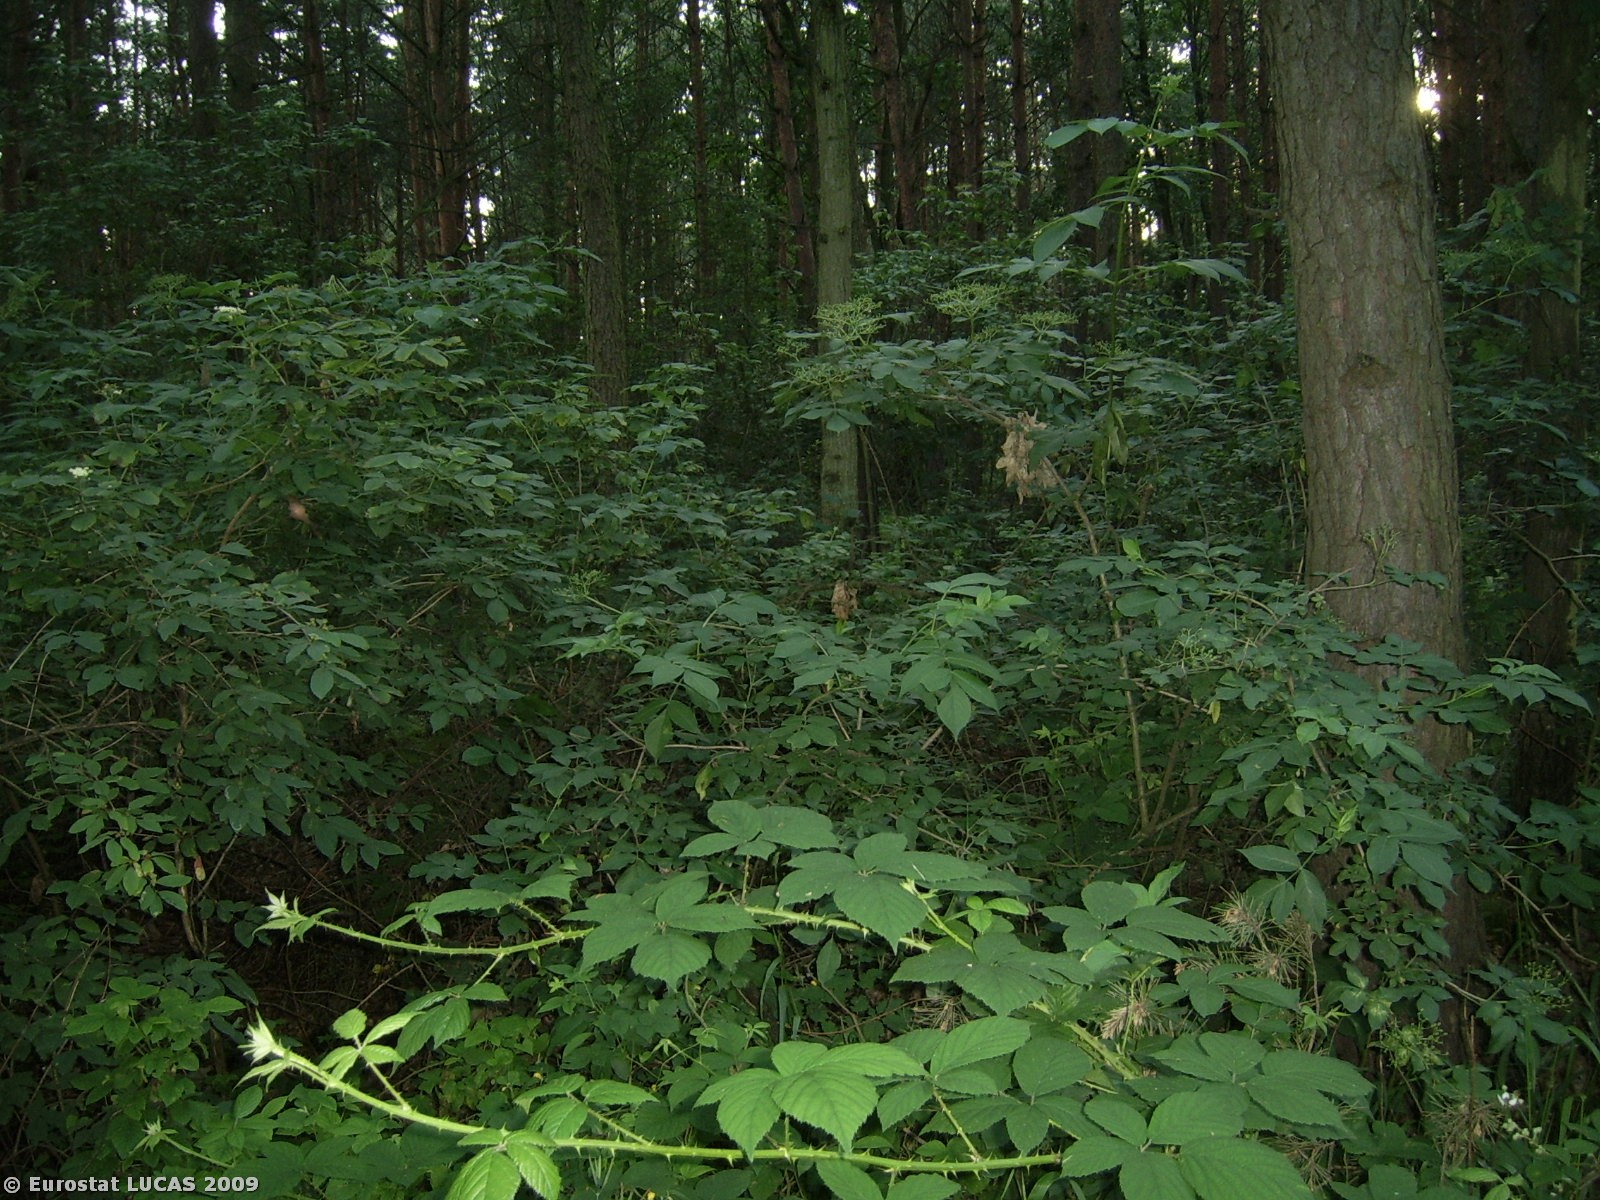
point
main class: Woodland
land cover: Mixed woodland
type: hemiboreal forest and nemoral coniferous forest and mixed broadleaved-coniferous forest
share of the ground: > 75 %
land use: Unused
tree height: > 5 m
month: July
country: PL
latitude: 53.1219
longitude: 17.6787
